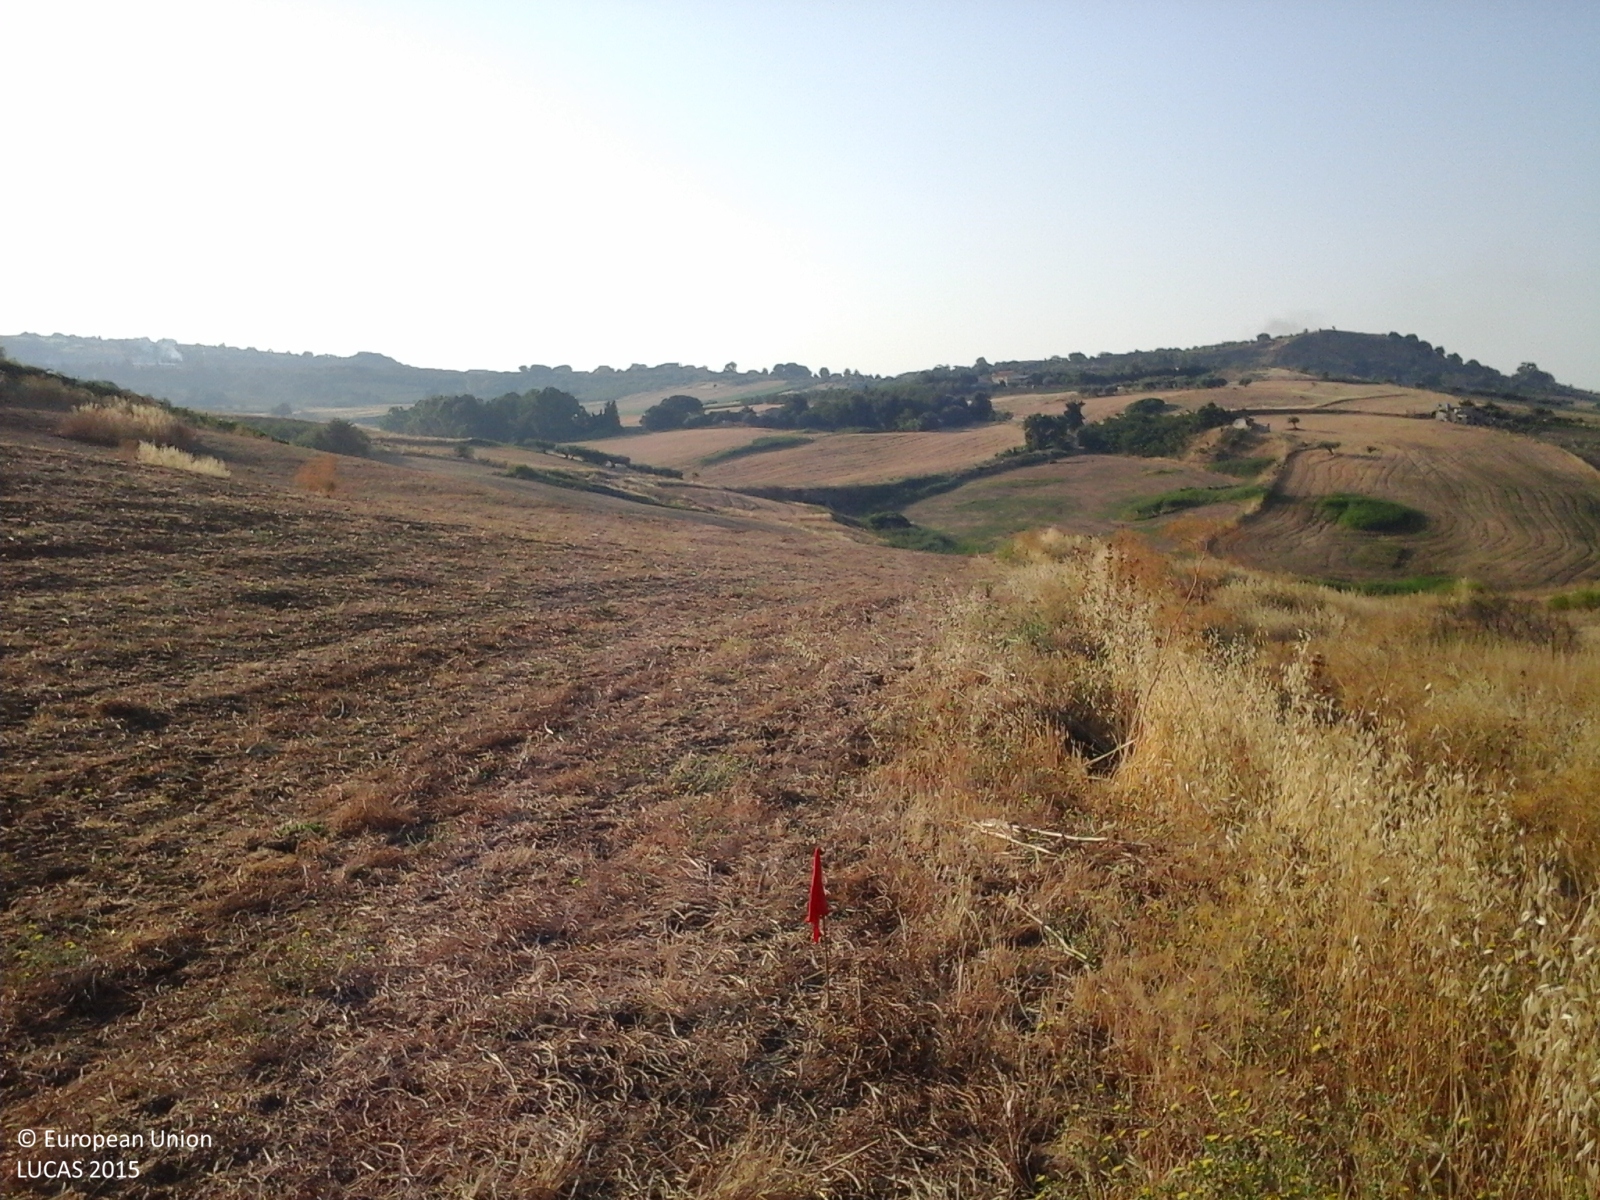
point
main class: Cropland
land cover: Temporary grasslands
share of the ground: > 75 %
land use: Agriculture (excluding fallow land and kitchen gardens)
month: July
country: IT
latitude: 37.2729
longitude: 13.7711
